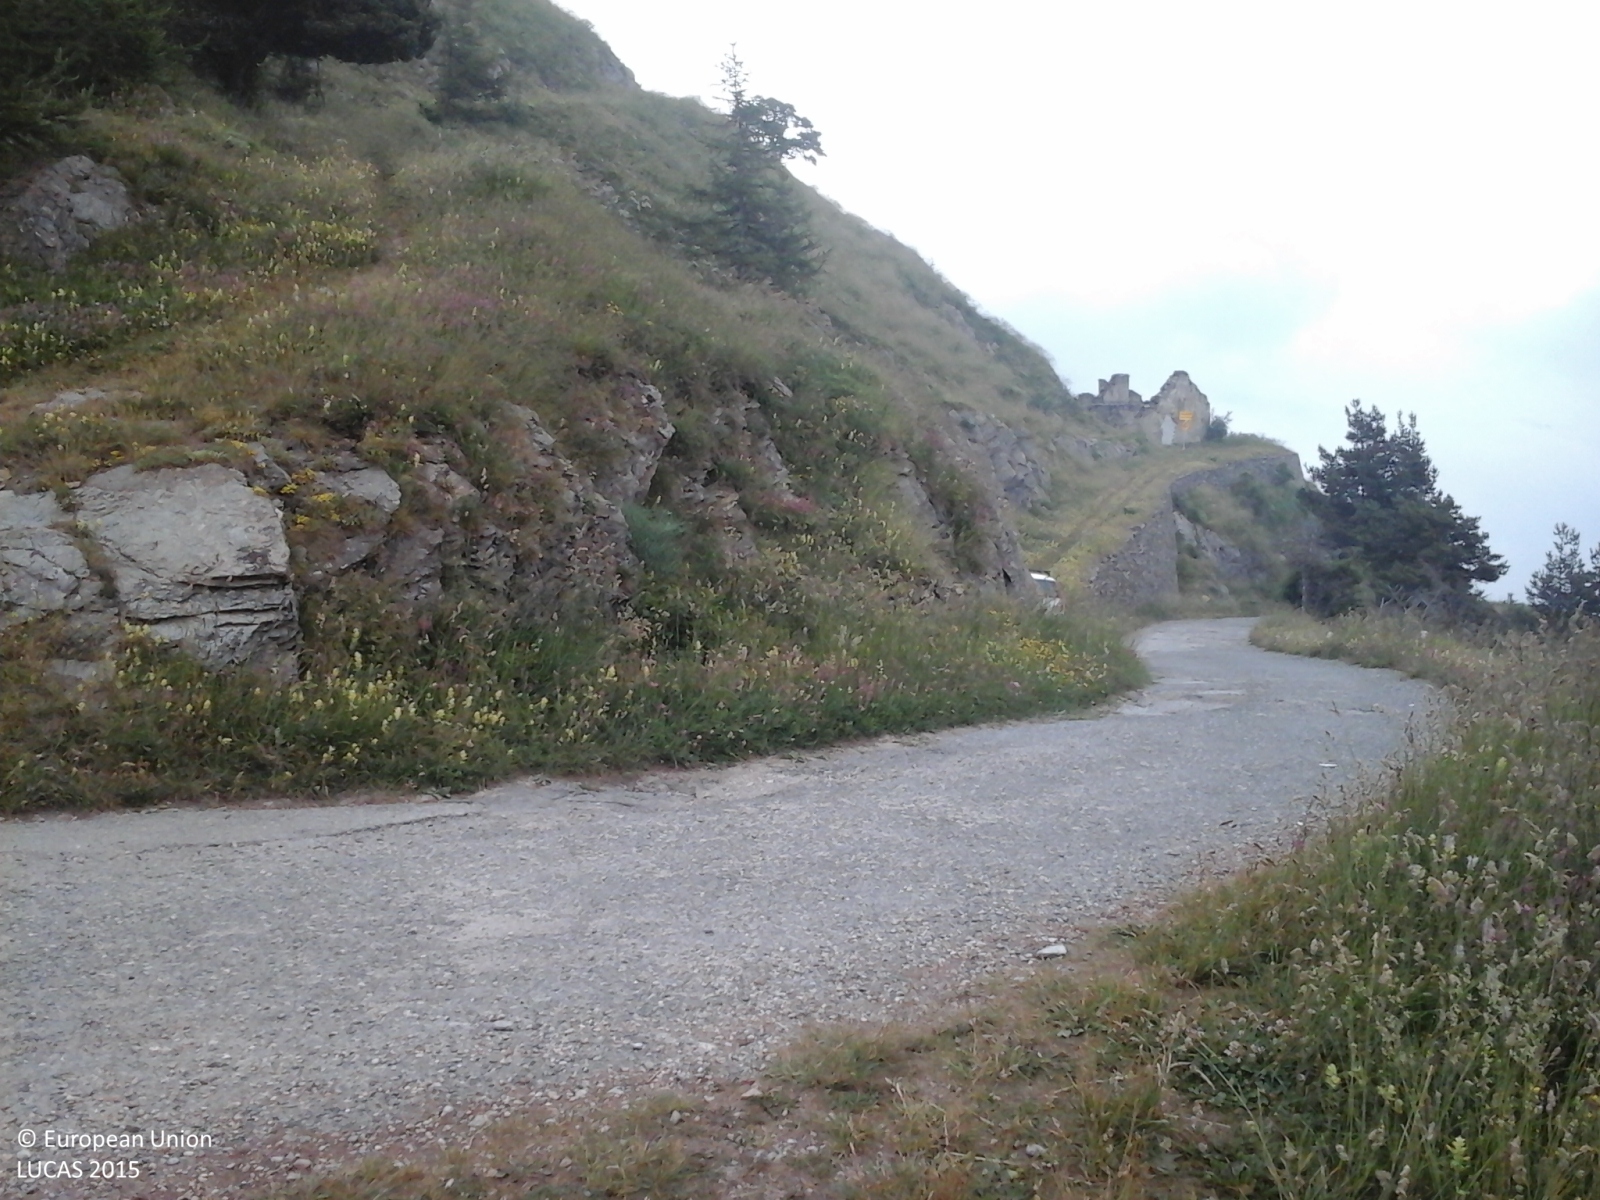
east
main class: Grassland
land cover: Grassland with sparse tree/shrub cover
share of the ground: > 75 %
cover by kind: herbaceous plants 95 %, coniferous forest trees 5 %
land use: Semi-natural and natural areas not in use
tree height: > 5 m
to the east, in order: Grassland with sparse tree/shrub cover; Other coniferous woodland; Grassland without tree/shrub cover; Other coniferous woodland
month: July
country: IT
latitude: 45.0483
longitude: 7.0466
